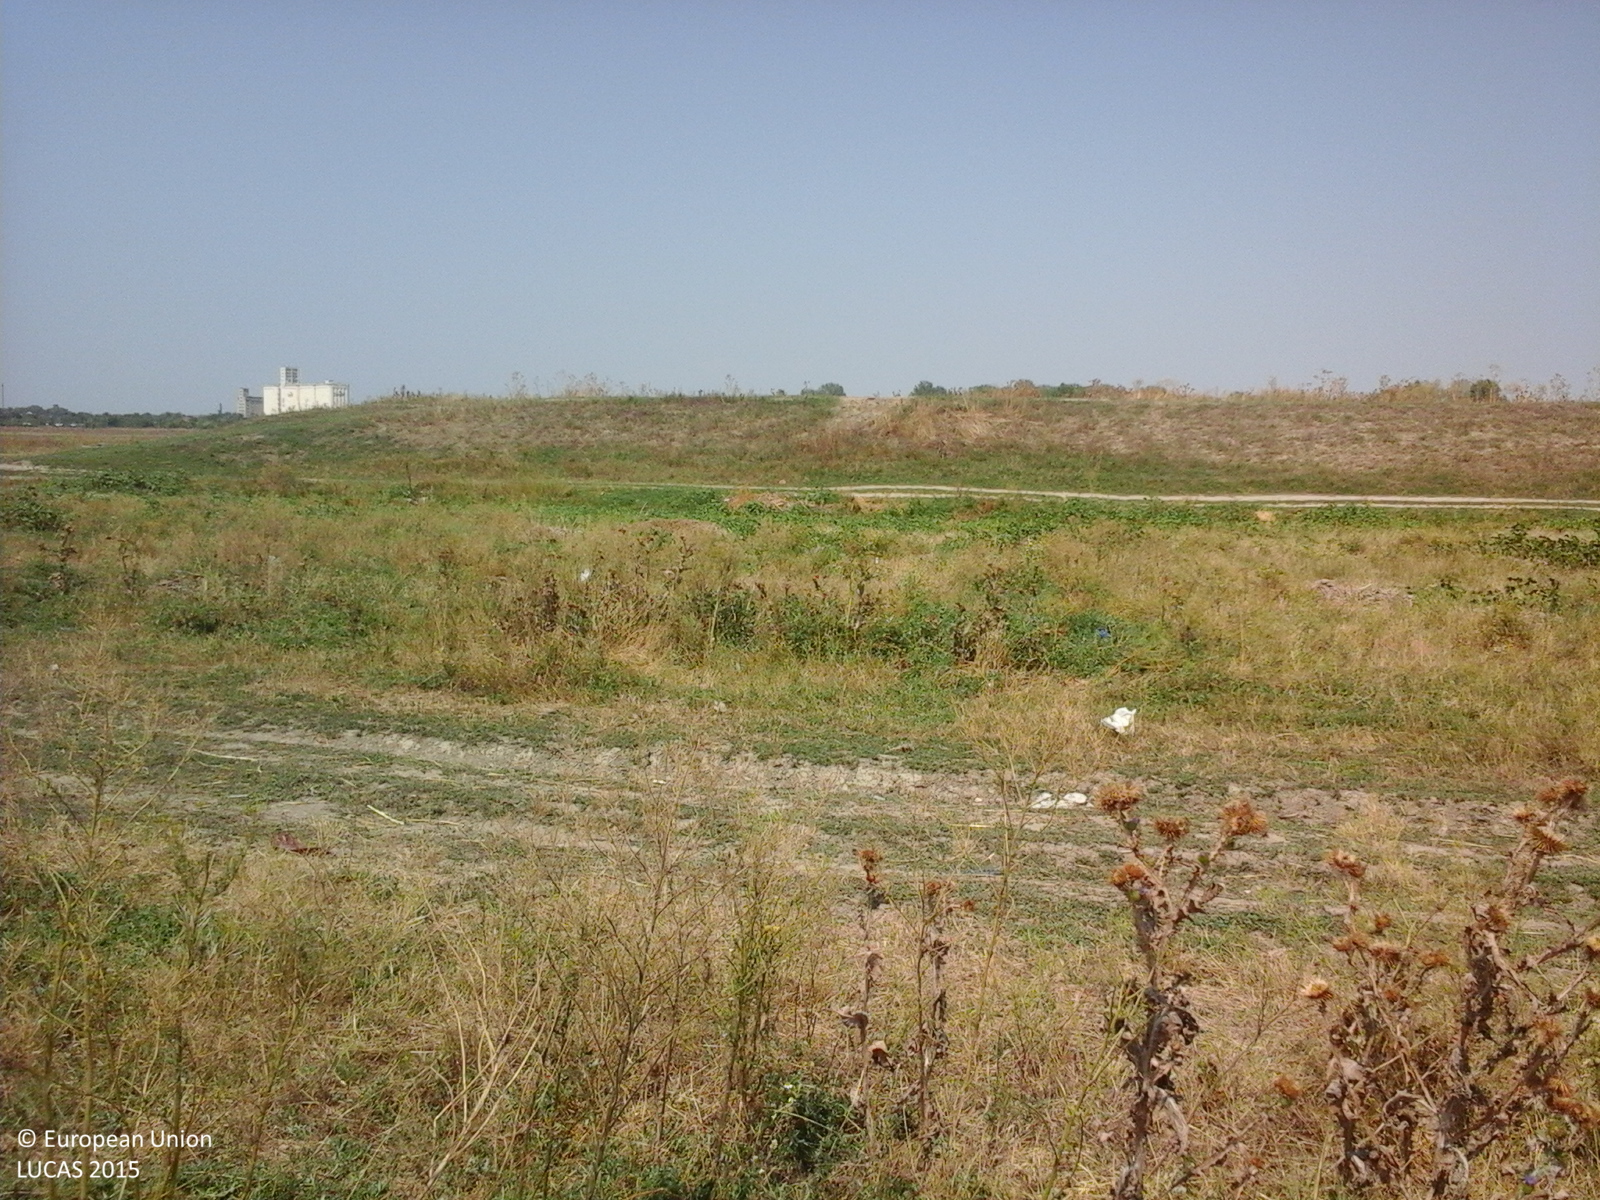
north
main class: Grassland
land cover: Spontaneously vegetated surfaces
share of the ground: > 75 %
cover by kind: herbaceous plants 100 %
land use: Fallow land
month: July
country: RO
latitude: 45.4558
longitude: 27.7699
